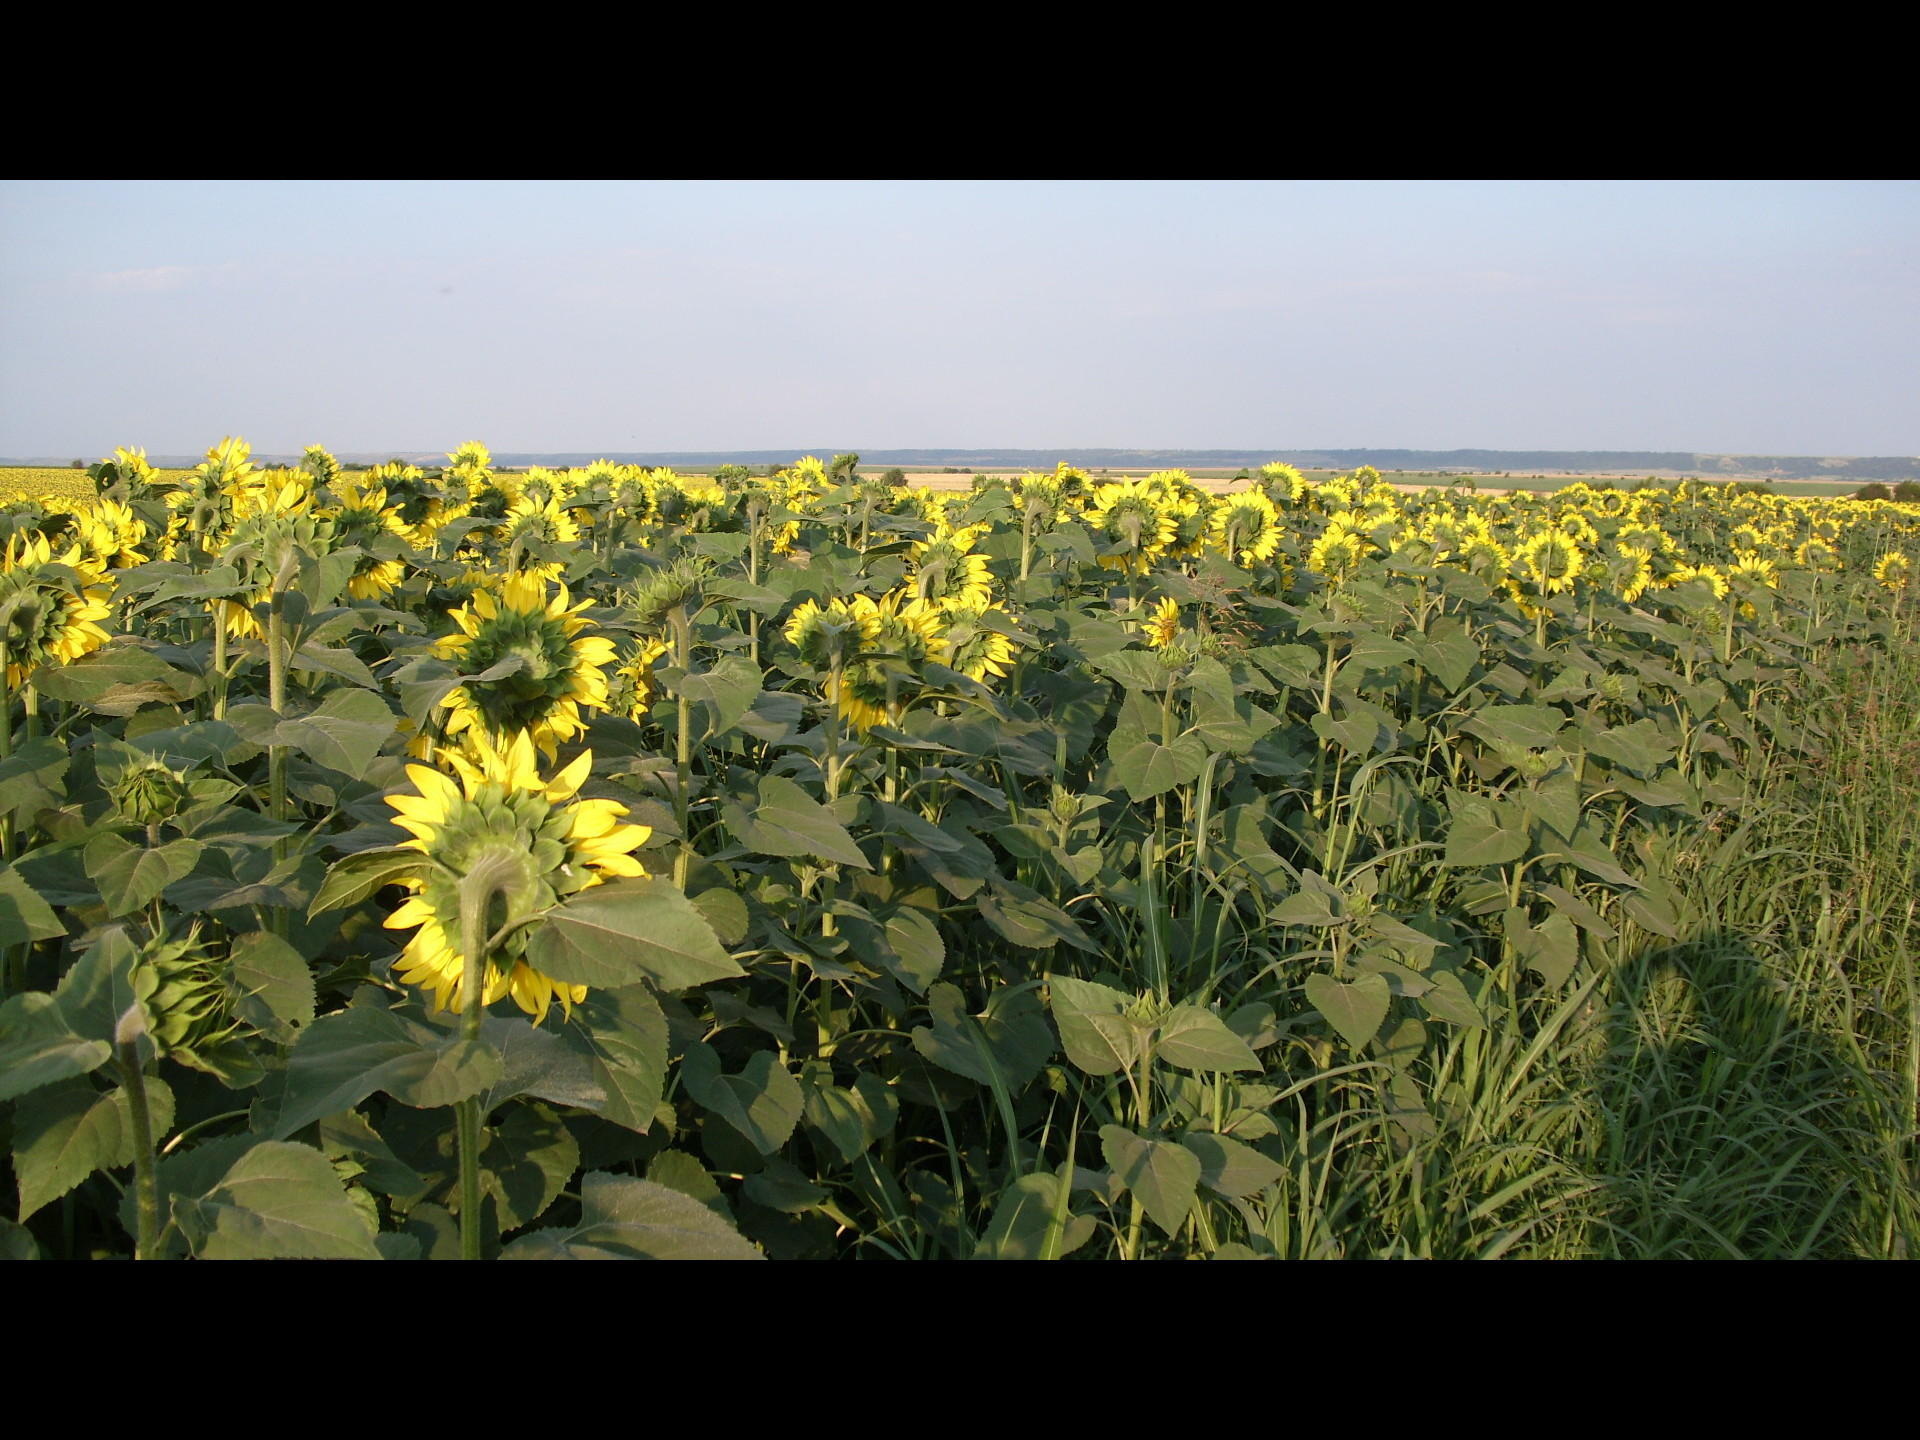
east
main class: Cropland
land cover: Sunflower
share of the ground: > 75 %
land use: Agriculture (excluding fallow land and kitchen gardens)
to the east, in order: Sunflower
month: July
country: BG
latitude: 43.7541
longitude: 23.0938
